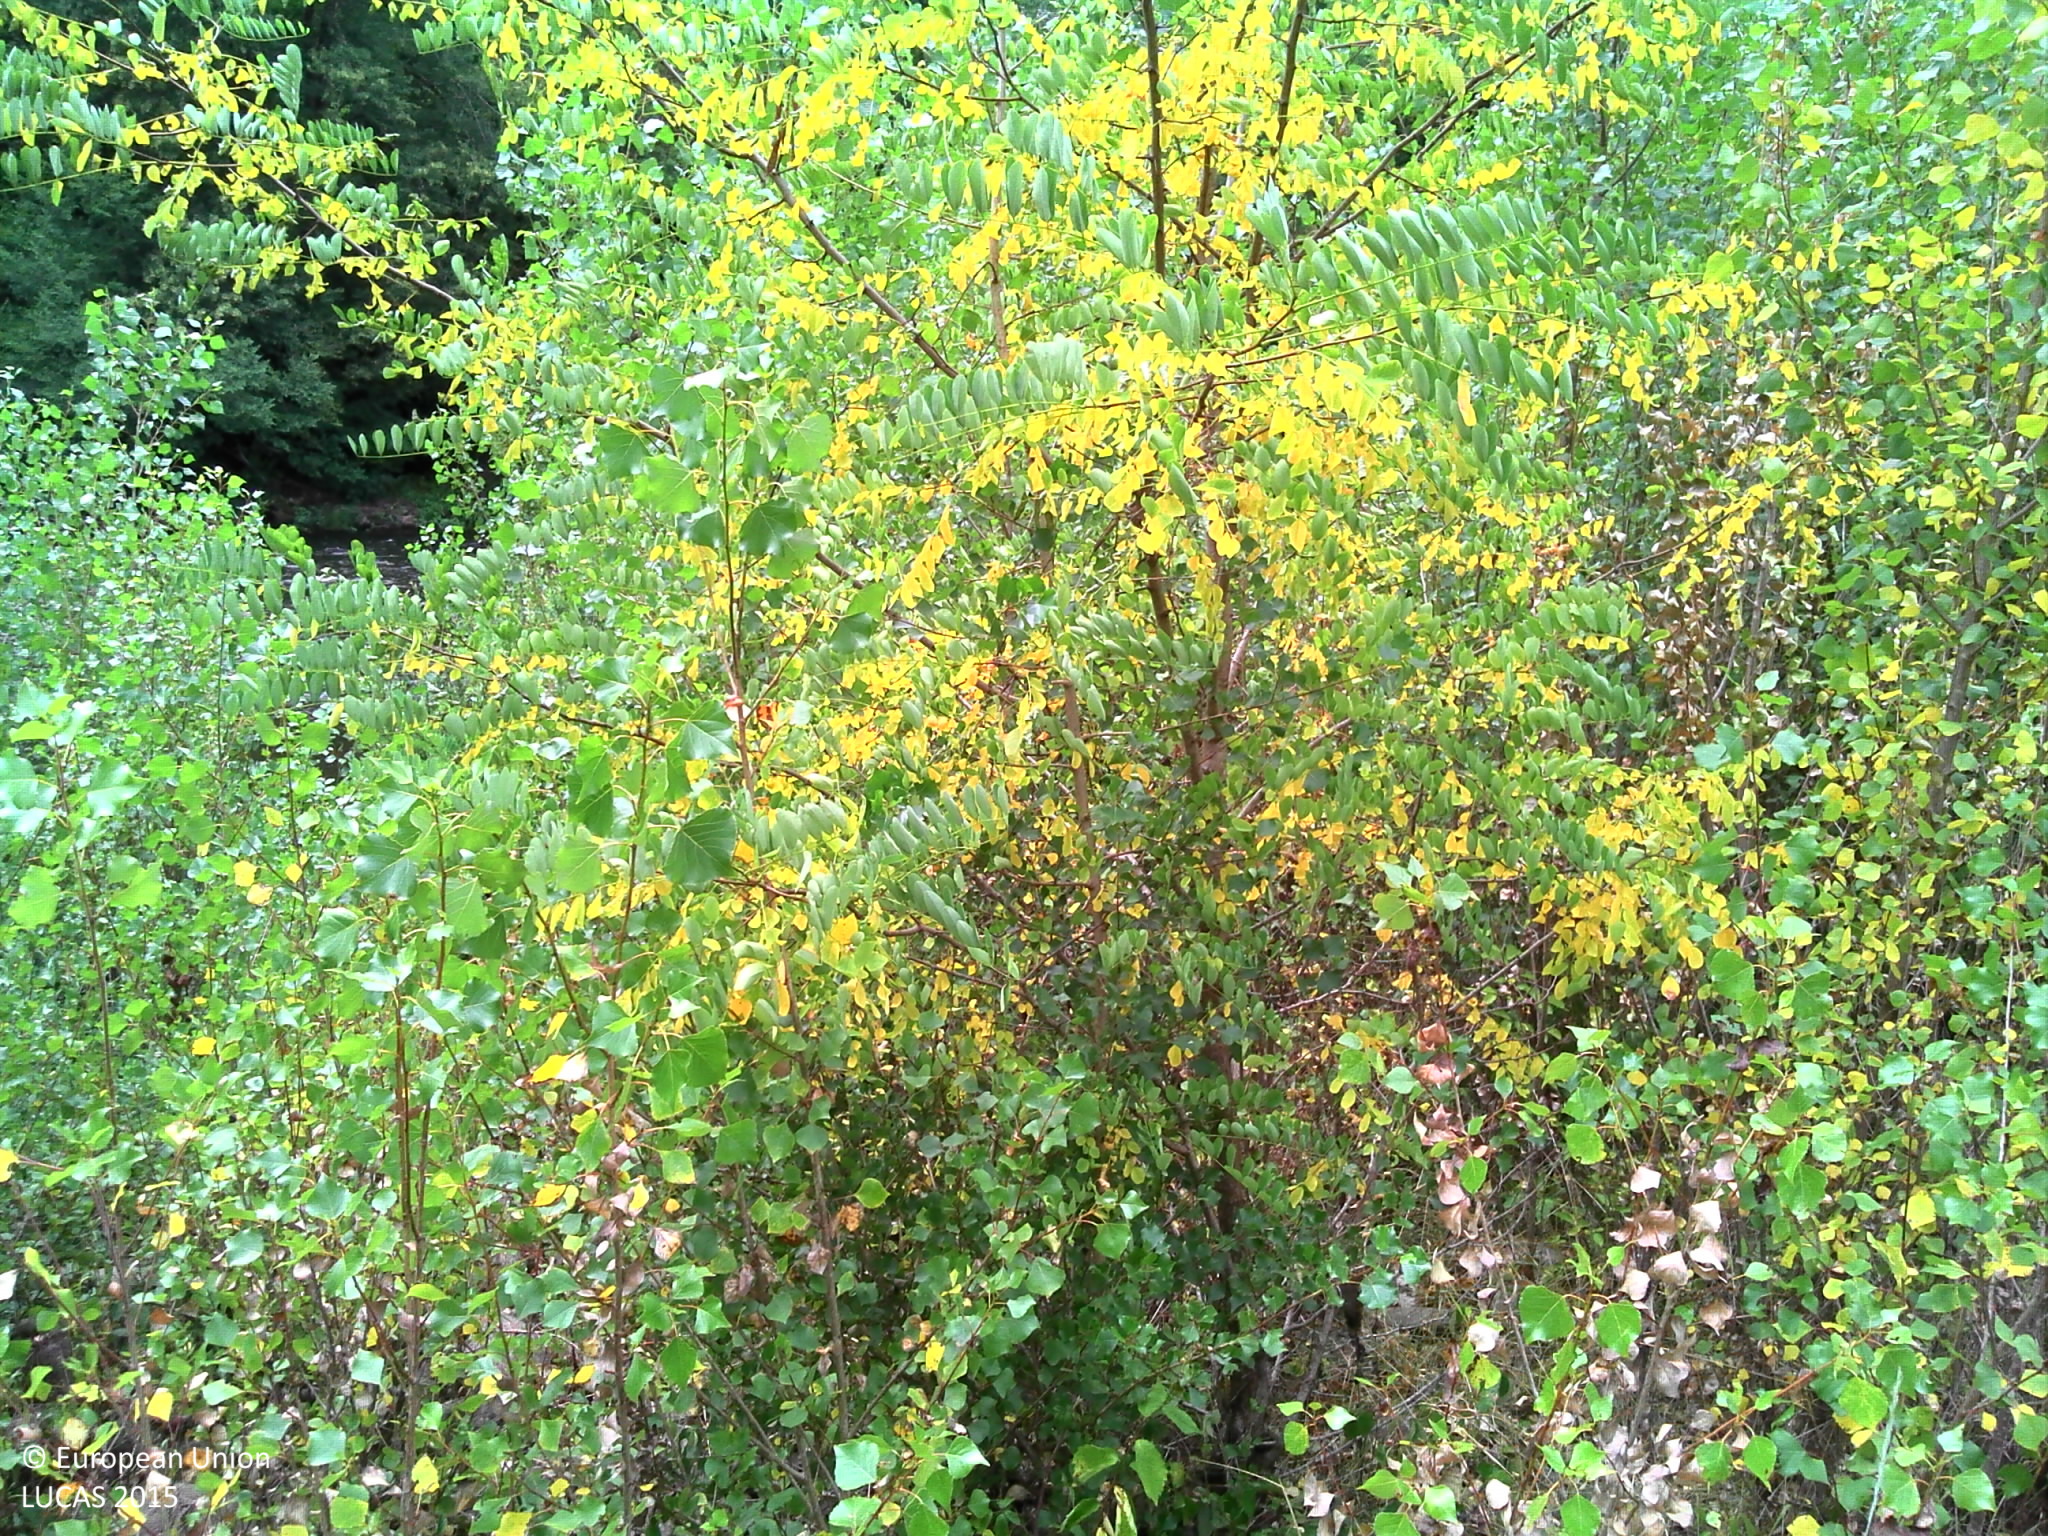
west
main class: Shrubland
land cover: Shrubland with sparse tree cover
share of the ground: > 75 %
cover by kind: shrubs 60 %, herbaceous plants 35 %, broadleaved forest trees 5 %
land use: Agriculture (excluding fallow land and kitchen gardens)
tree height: > 5 m
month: July
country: FR
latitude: 44.6438
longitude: 2.5507
